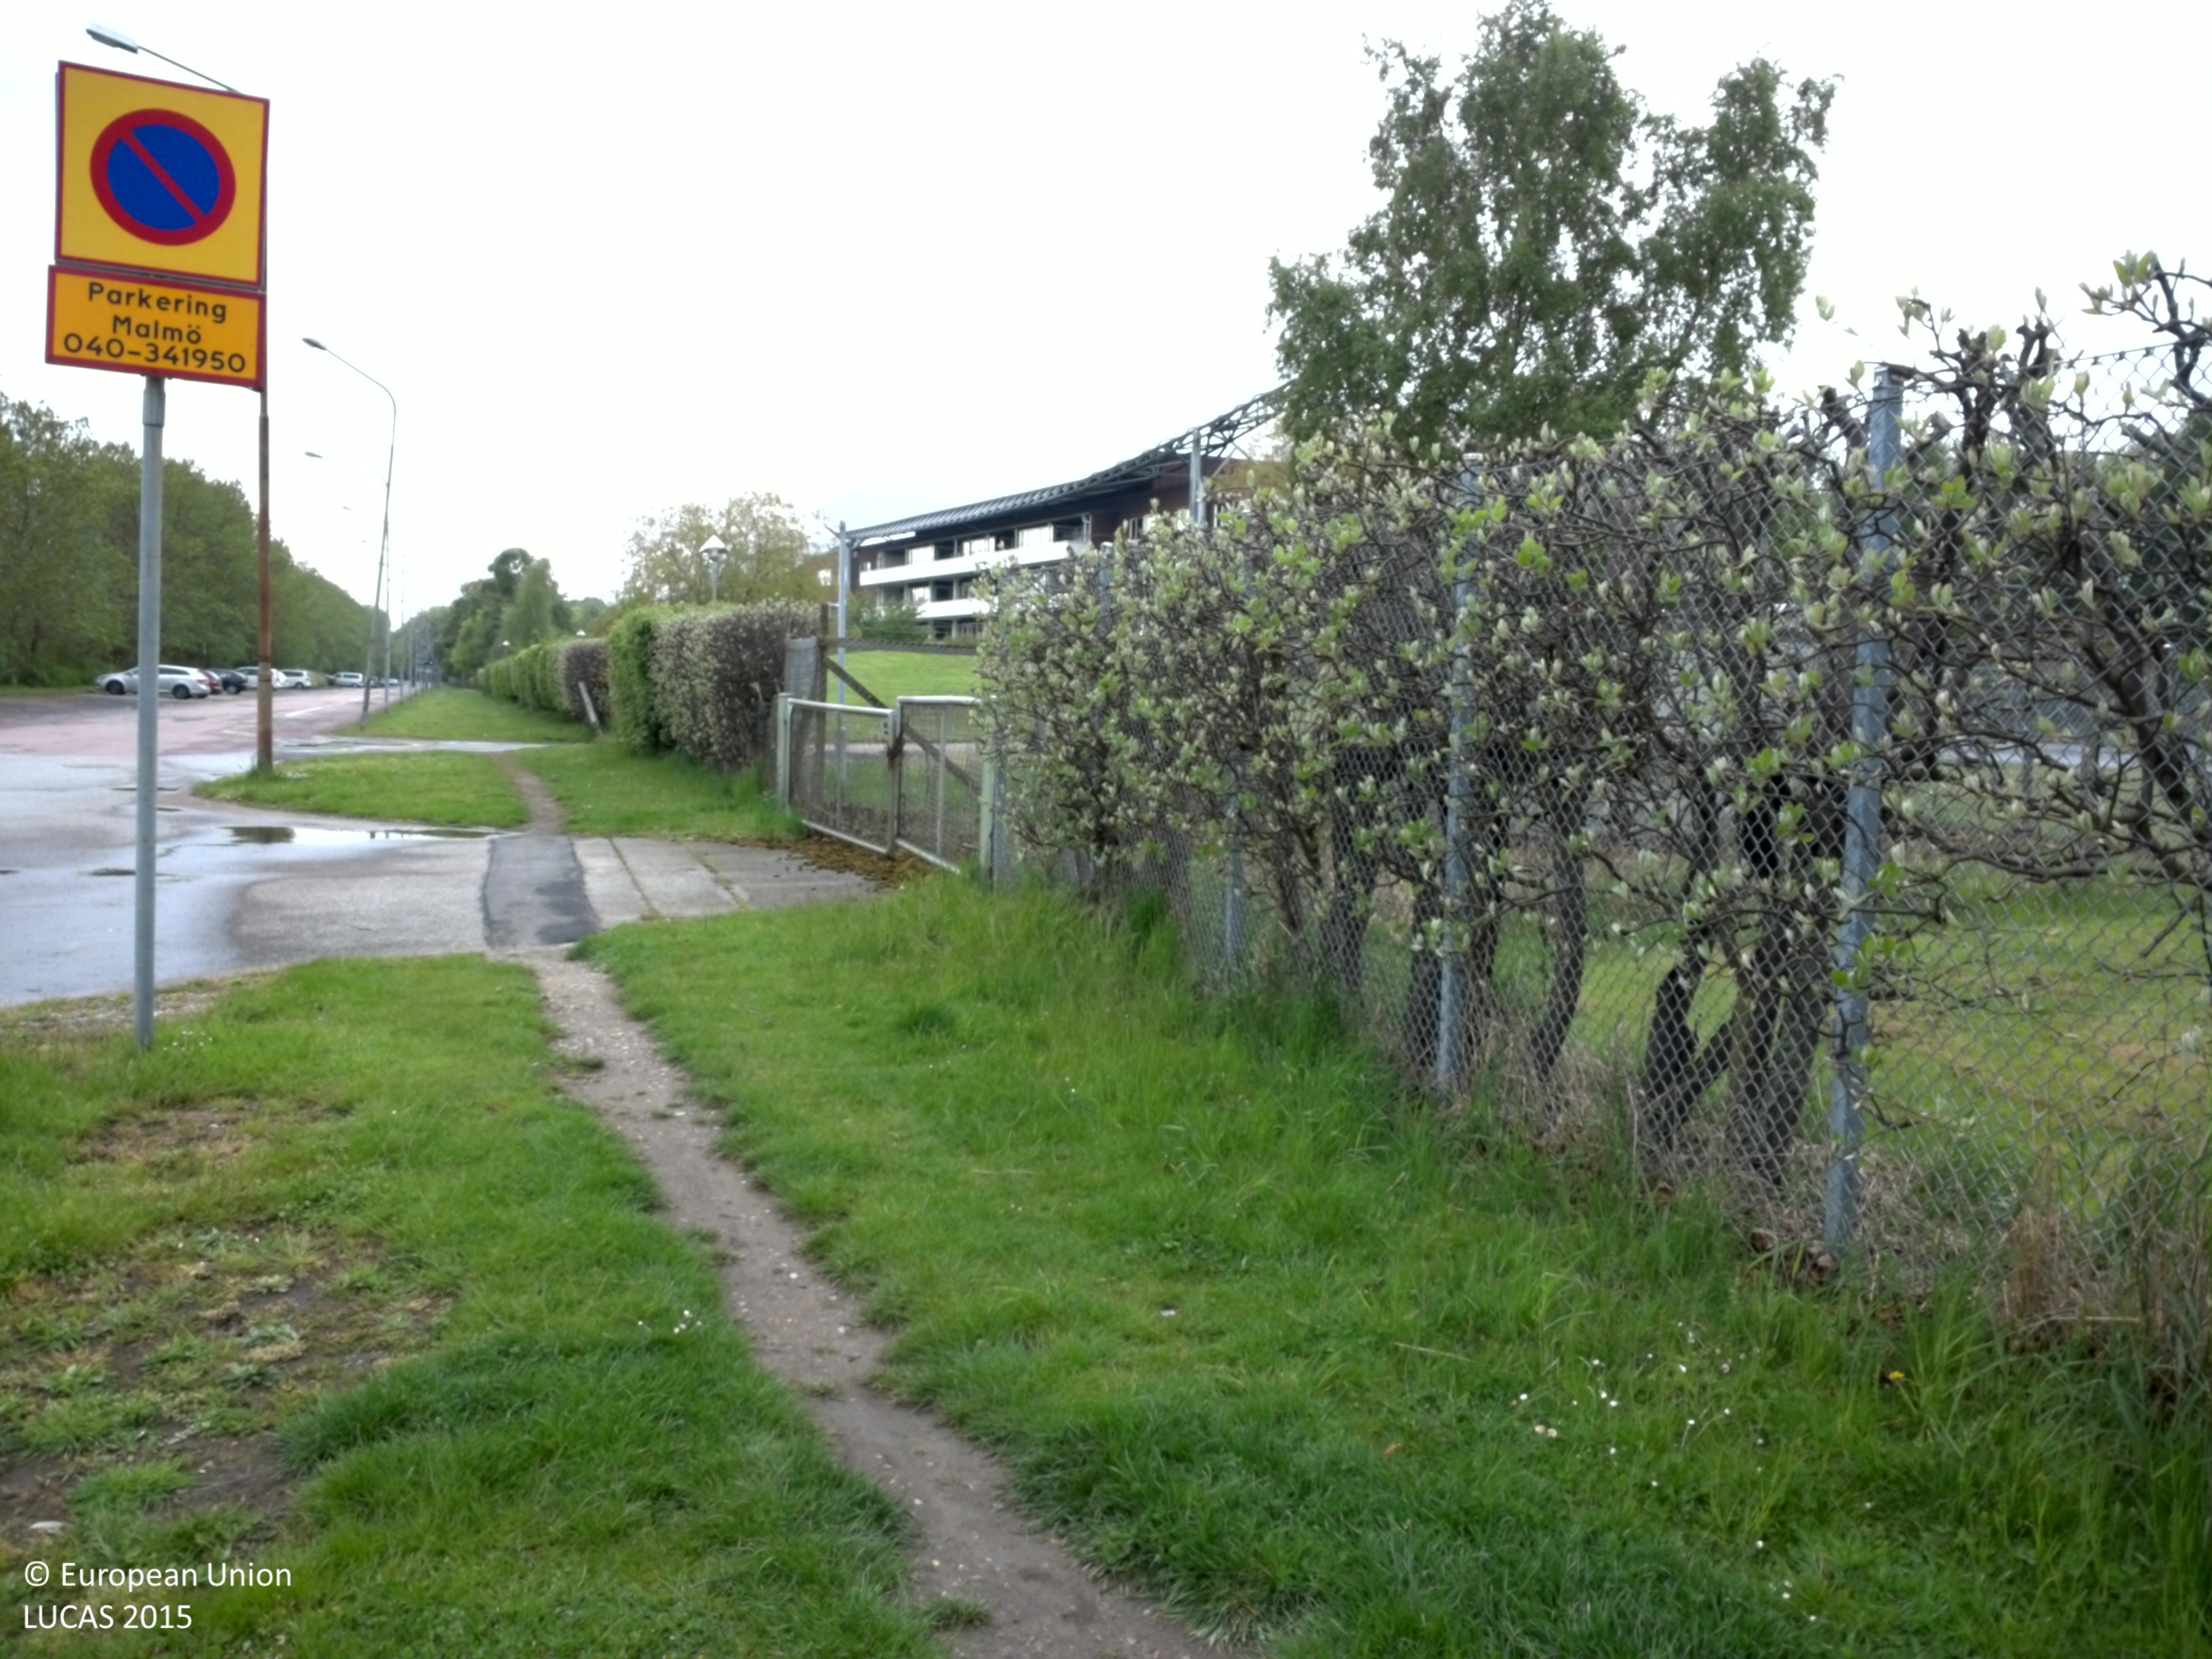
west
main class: Grassland
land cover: Grassland without tree/shrub cover
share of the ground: > 75 %
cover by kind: herbaceous plants 100 %
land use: Road transport
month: May
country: SE
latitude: 55.6116
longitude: 13.0620
